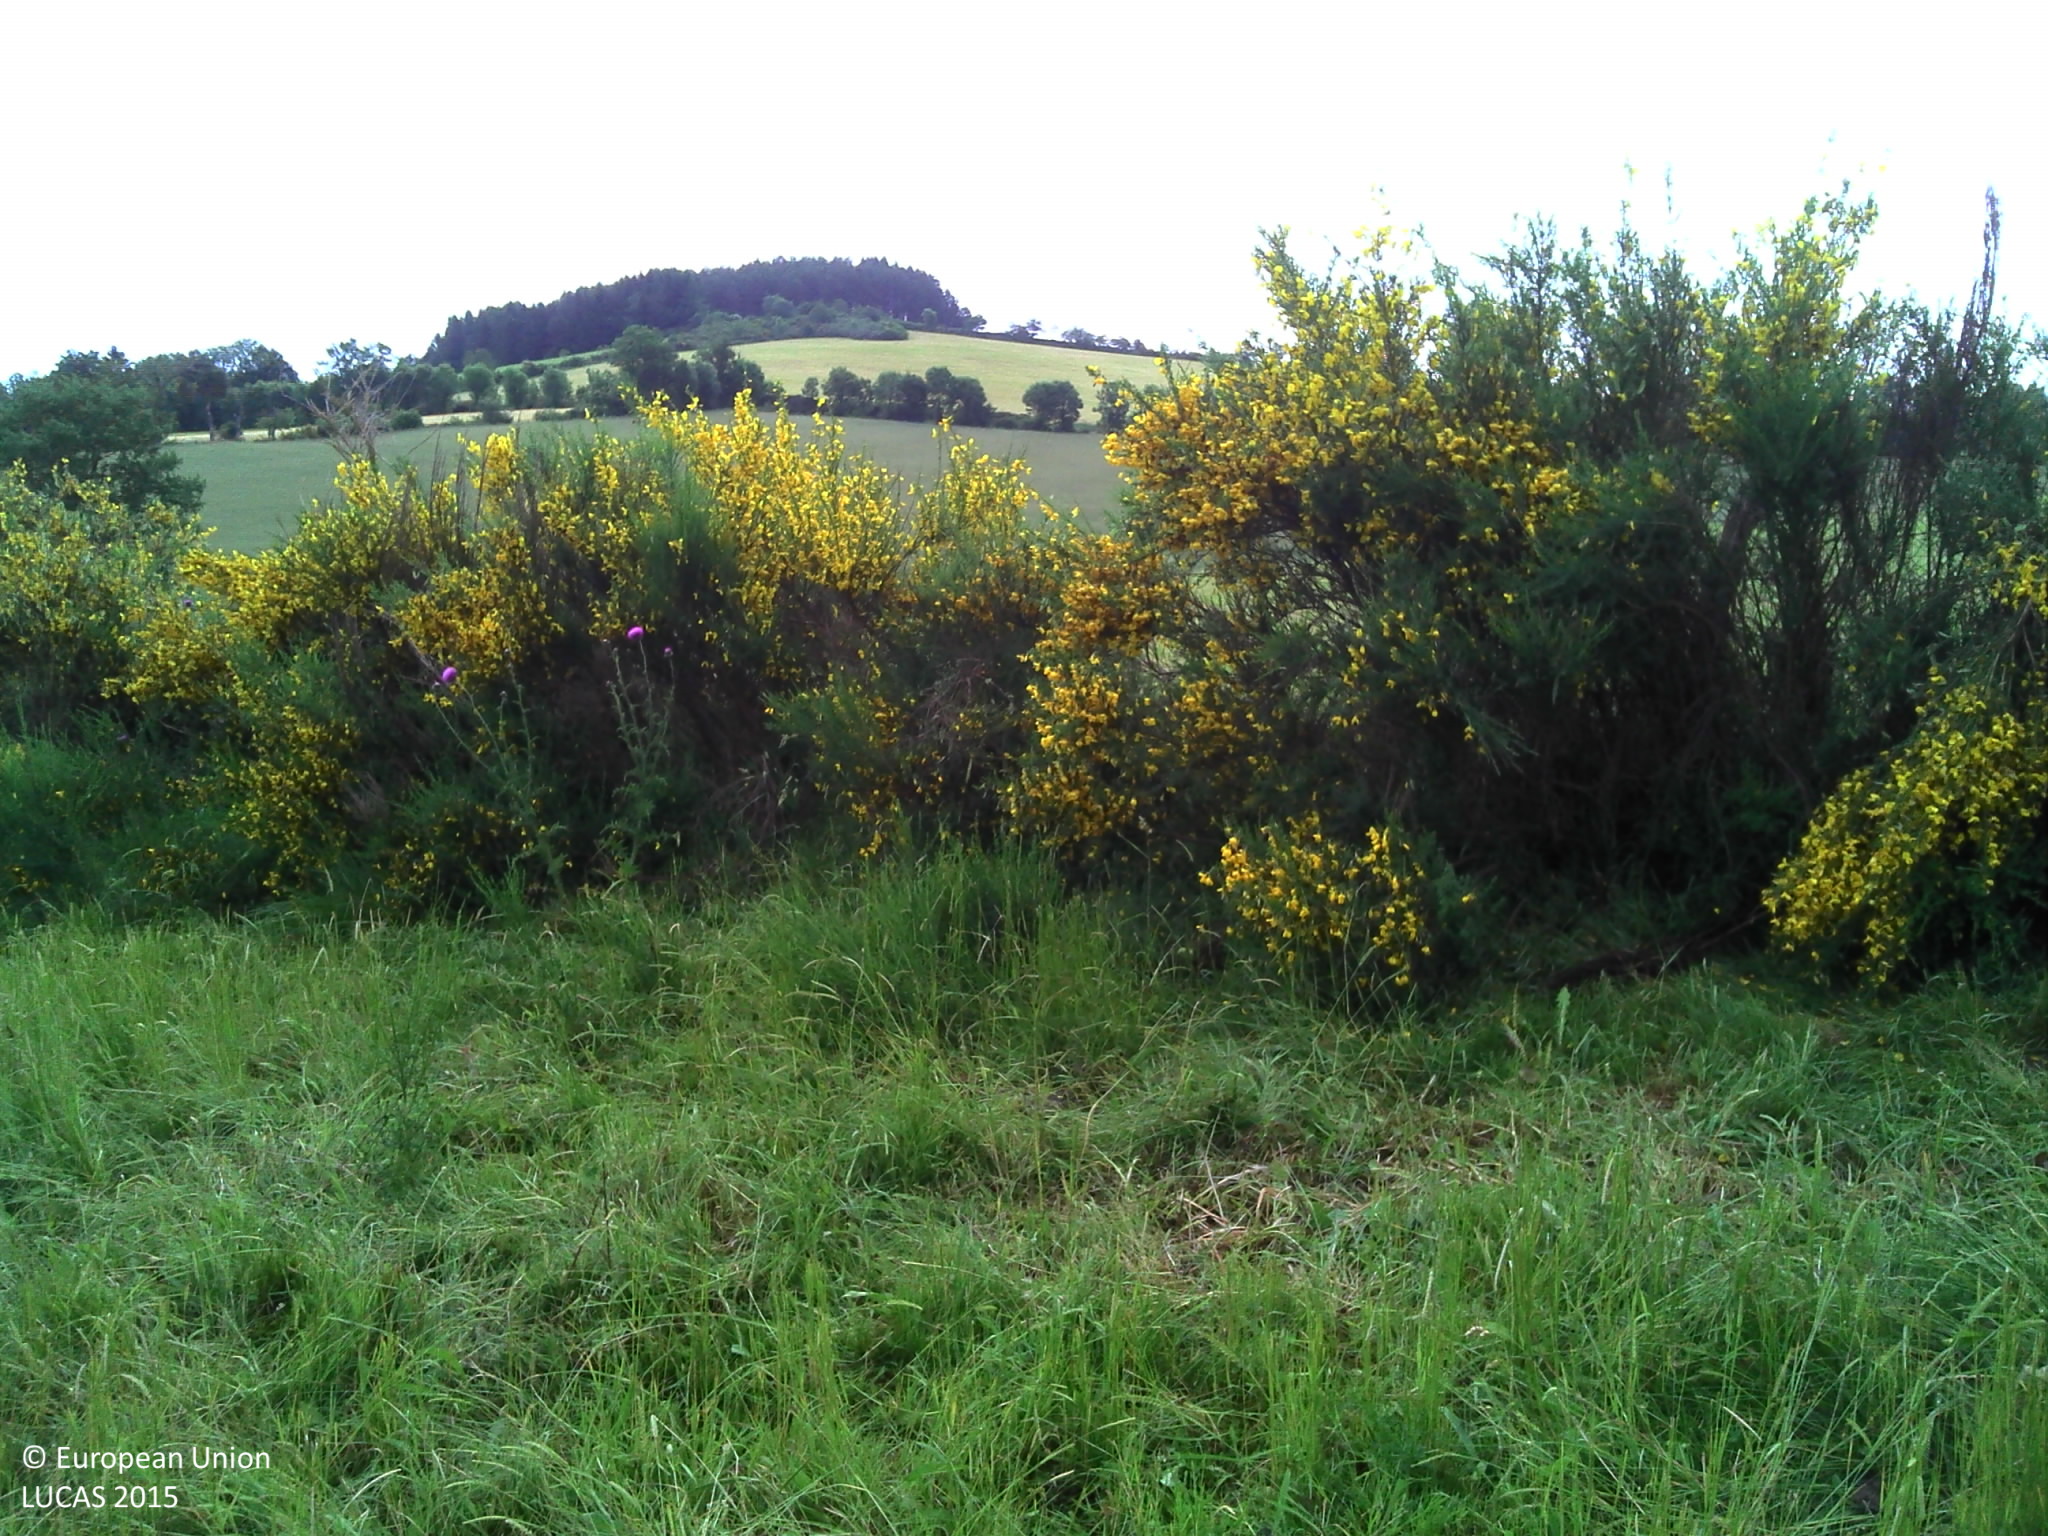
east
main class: Grassland
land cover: Grassland without tree/shrub cover
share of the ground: > 75 %
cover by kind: herbaceous plants 95 %, shrubs 5 %
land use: Agriculture (excluding fallow land and kitchen gardens)
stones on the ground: 10 - 25 %
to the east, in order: Grassland without tree/shrub cover; Shrubland without tree cover; Fences; Grassland without tree/shrub cover; Shrubland without tree cover; Rivers and streams; Shrubland without tree cover; Fences; Triticale
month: June
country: FR
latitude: 44.2574
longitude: 2.9784
